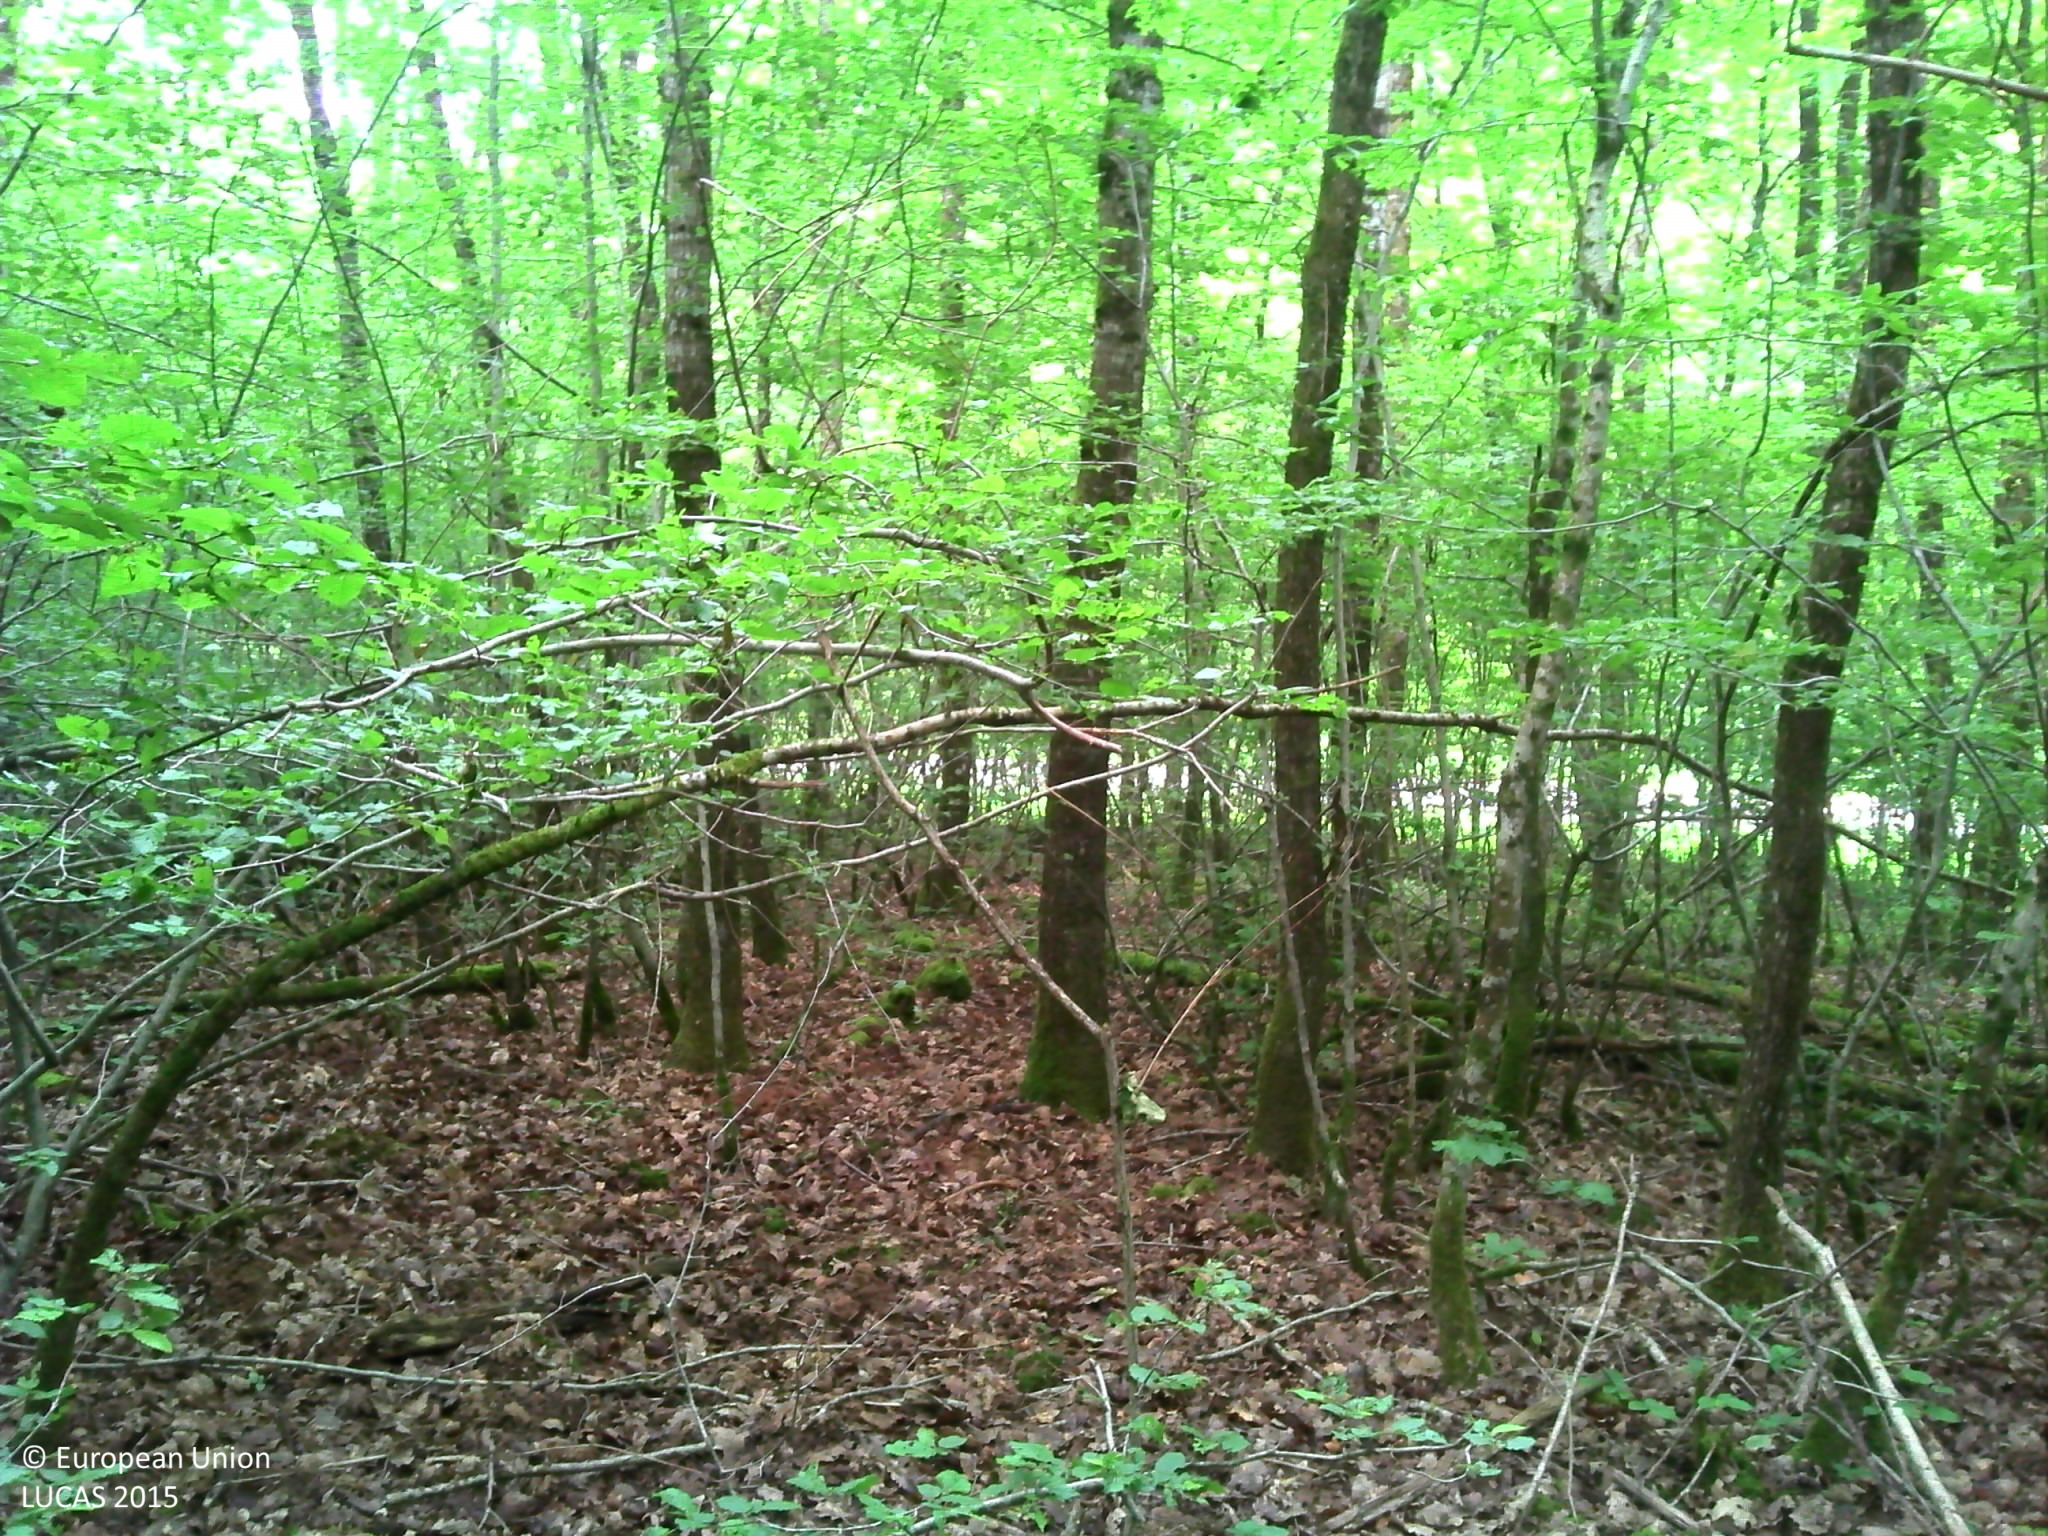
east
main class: Woodland
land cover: Broadleaved woodland
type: beech forest
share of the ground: > 75 %
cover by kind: broadleaved forest trees 95 %, herbaceous plants 5 %
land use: Forestry
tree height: > 5 m
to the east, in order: Broadleaved woodland; Ditches and canals; Grass margins; Paved roads, cycling and walking lanes; Grass margins; Spruce dominated mixed woodland; Grassland without tree/shrub cover
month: May
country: FR
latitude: 47.9271
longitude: 6.2936
